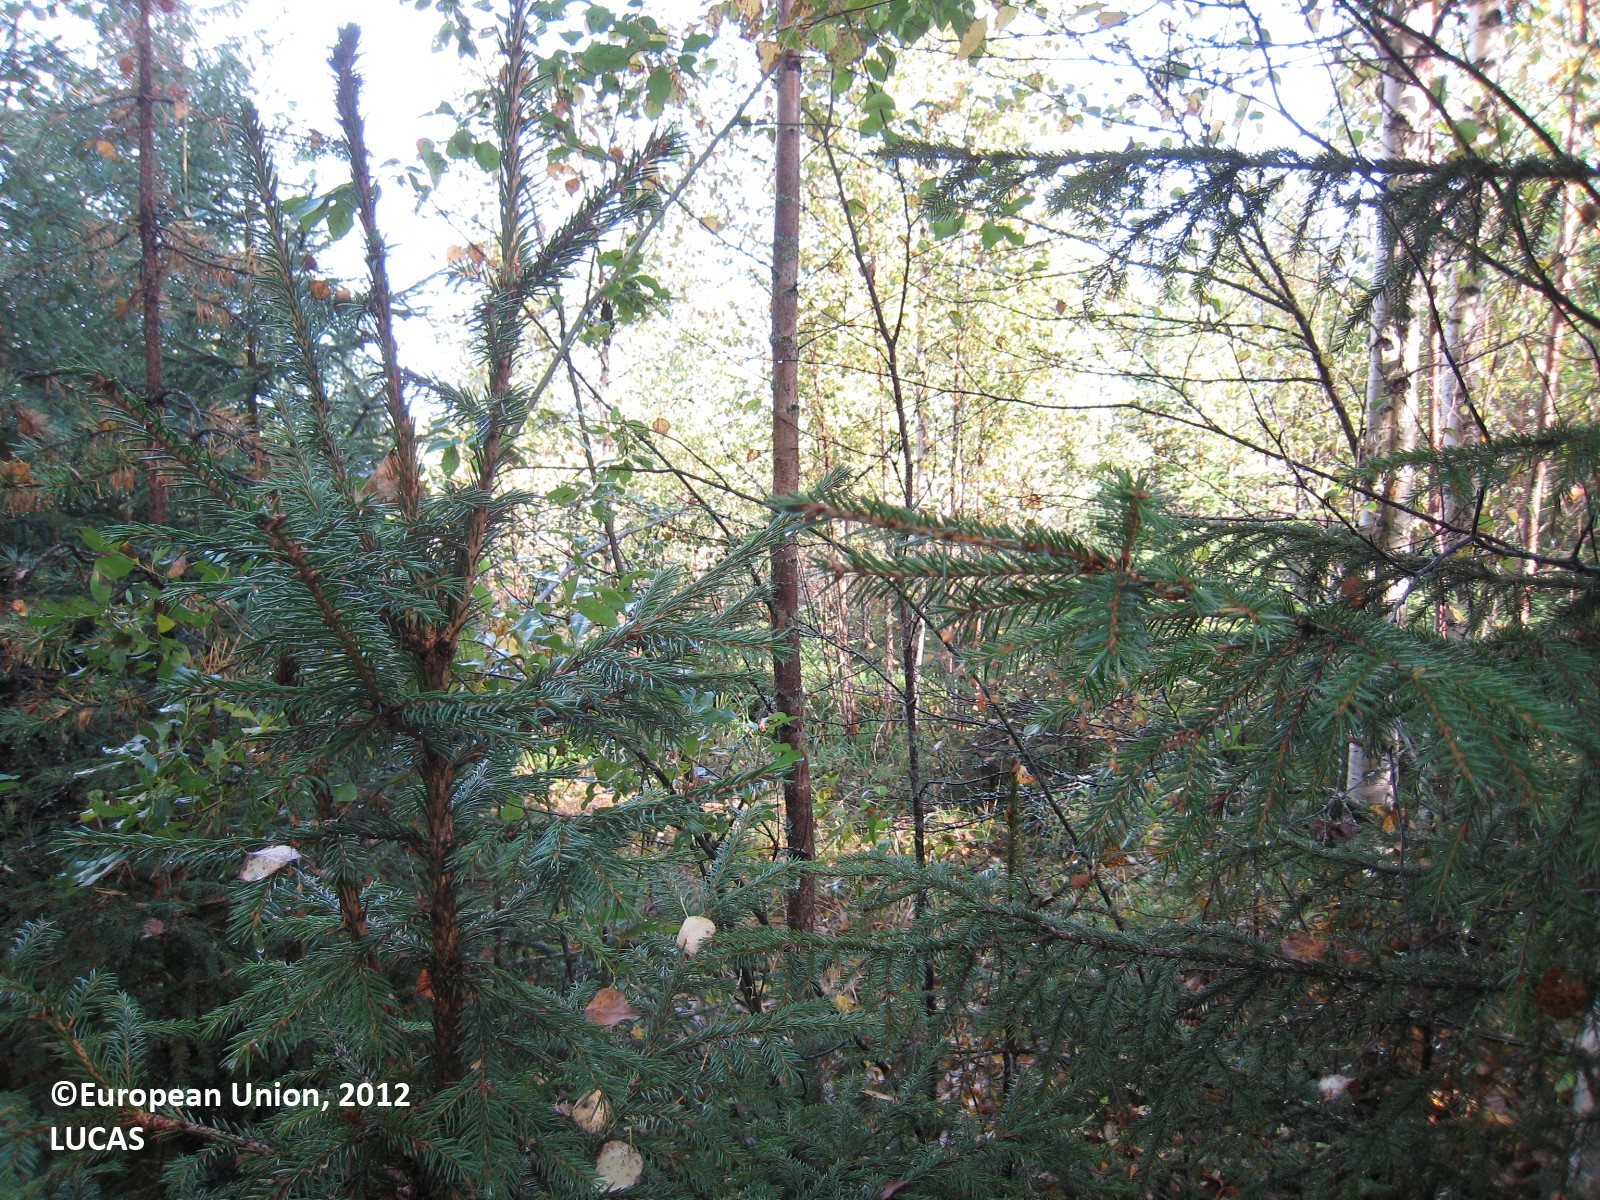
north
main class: Woodland
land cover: Spruce dominated mixed woodland
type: boreal forest
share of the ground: > 75 %
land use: Forestry
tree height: > 5 m
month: September
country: FI
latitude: 63.1110
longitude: 26.7257
